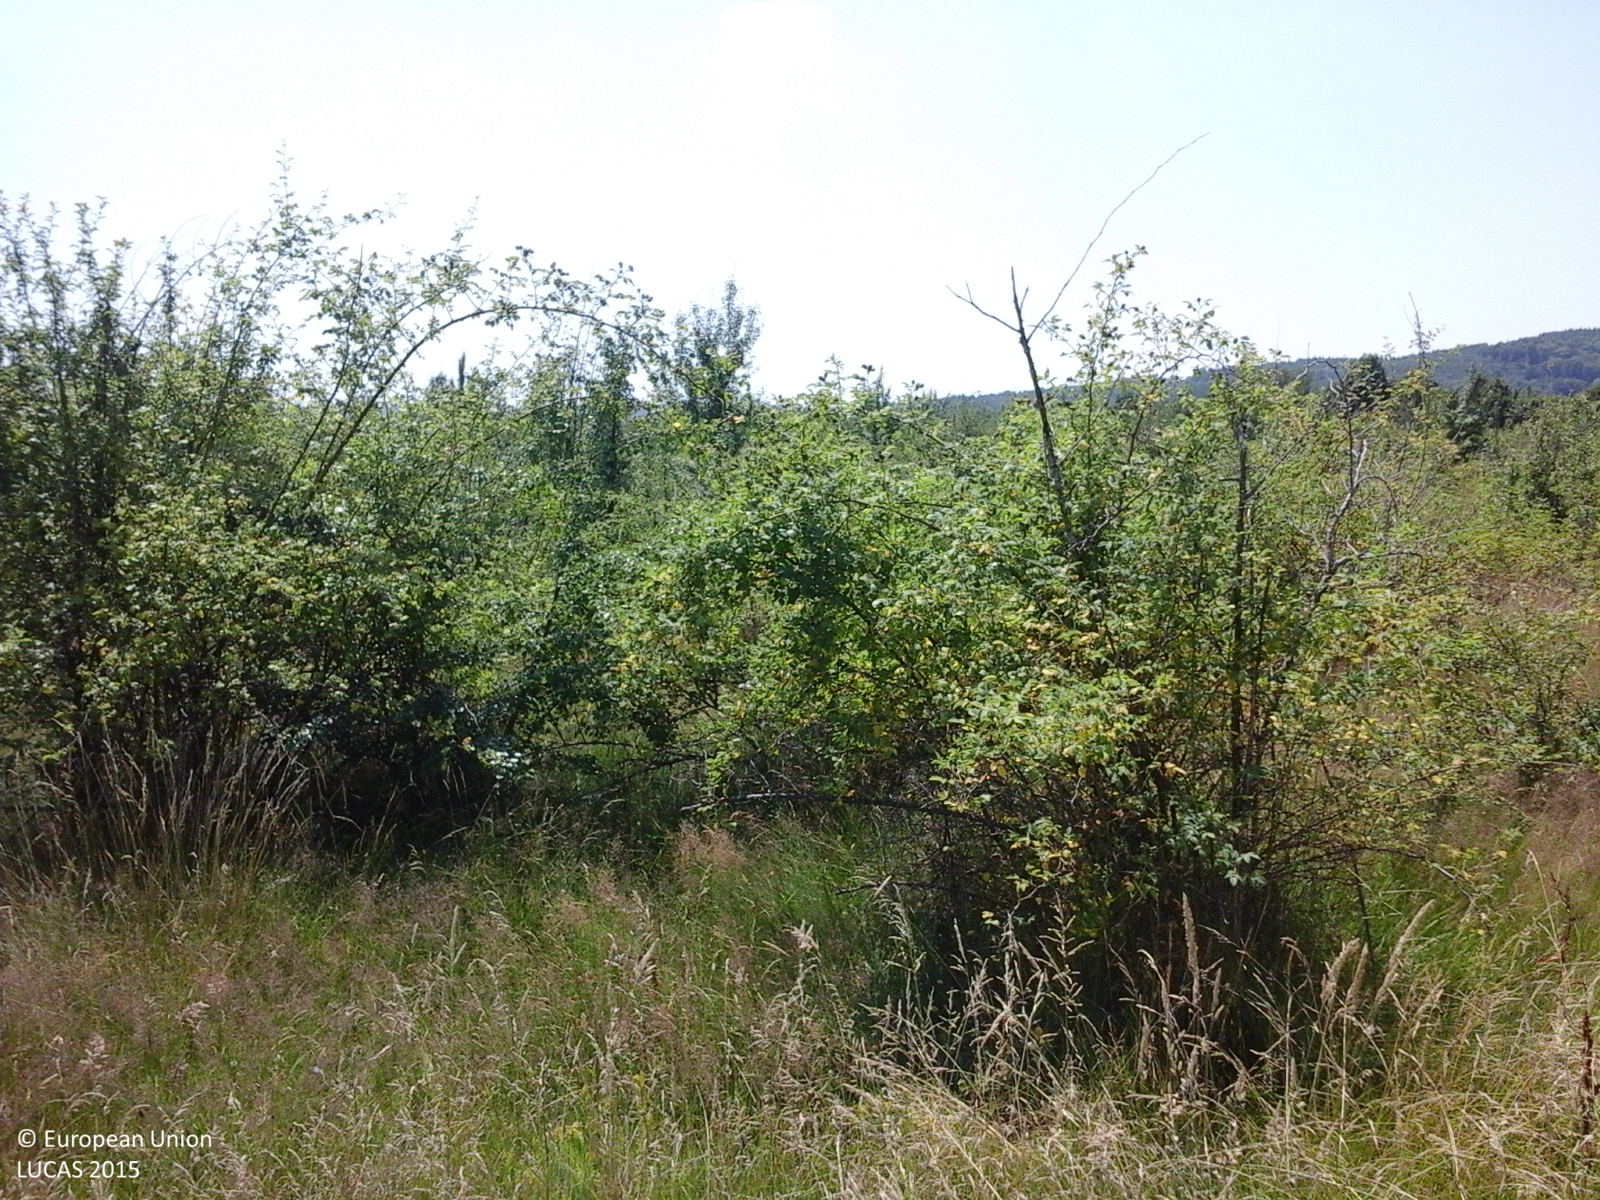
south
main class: Shrubland
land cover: Shrubland with sparse tree cover
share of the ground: > 75 %
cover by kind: shrubs 80 %, herbaceous plants 15 %, broadleaved forest trees 5 %
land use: Semi-natural and natural areas not in use
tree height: < 5 m
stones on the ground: < 10 %
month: July
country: RO
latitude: 45.0197
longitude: 24.6857
